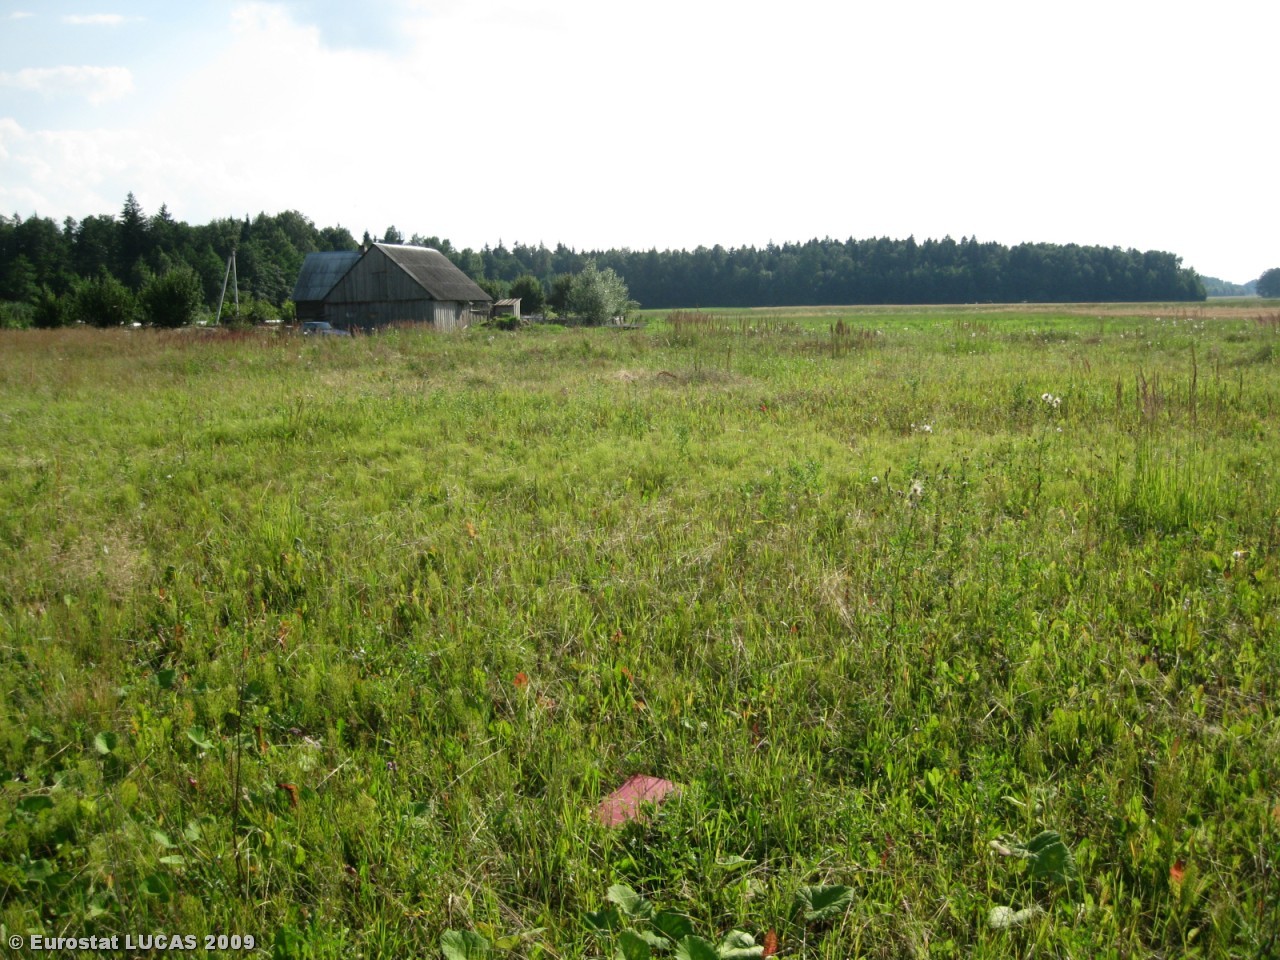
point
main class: Grassland
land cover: Grassland without tree/shrub cover
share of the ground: > 75 %
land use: Agriculture (excluding fallow land and kitchen gardens)
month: July
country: LT
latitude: 54.8408
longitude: 23.7419
